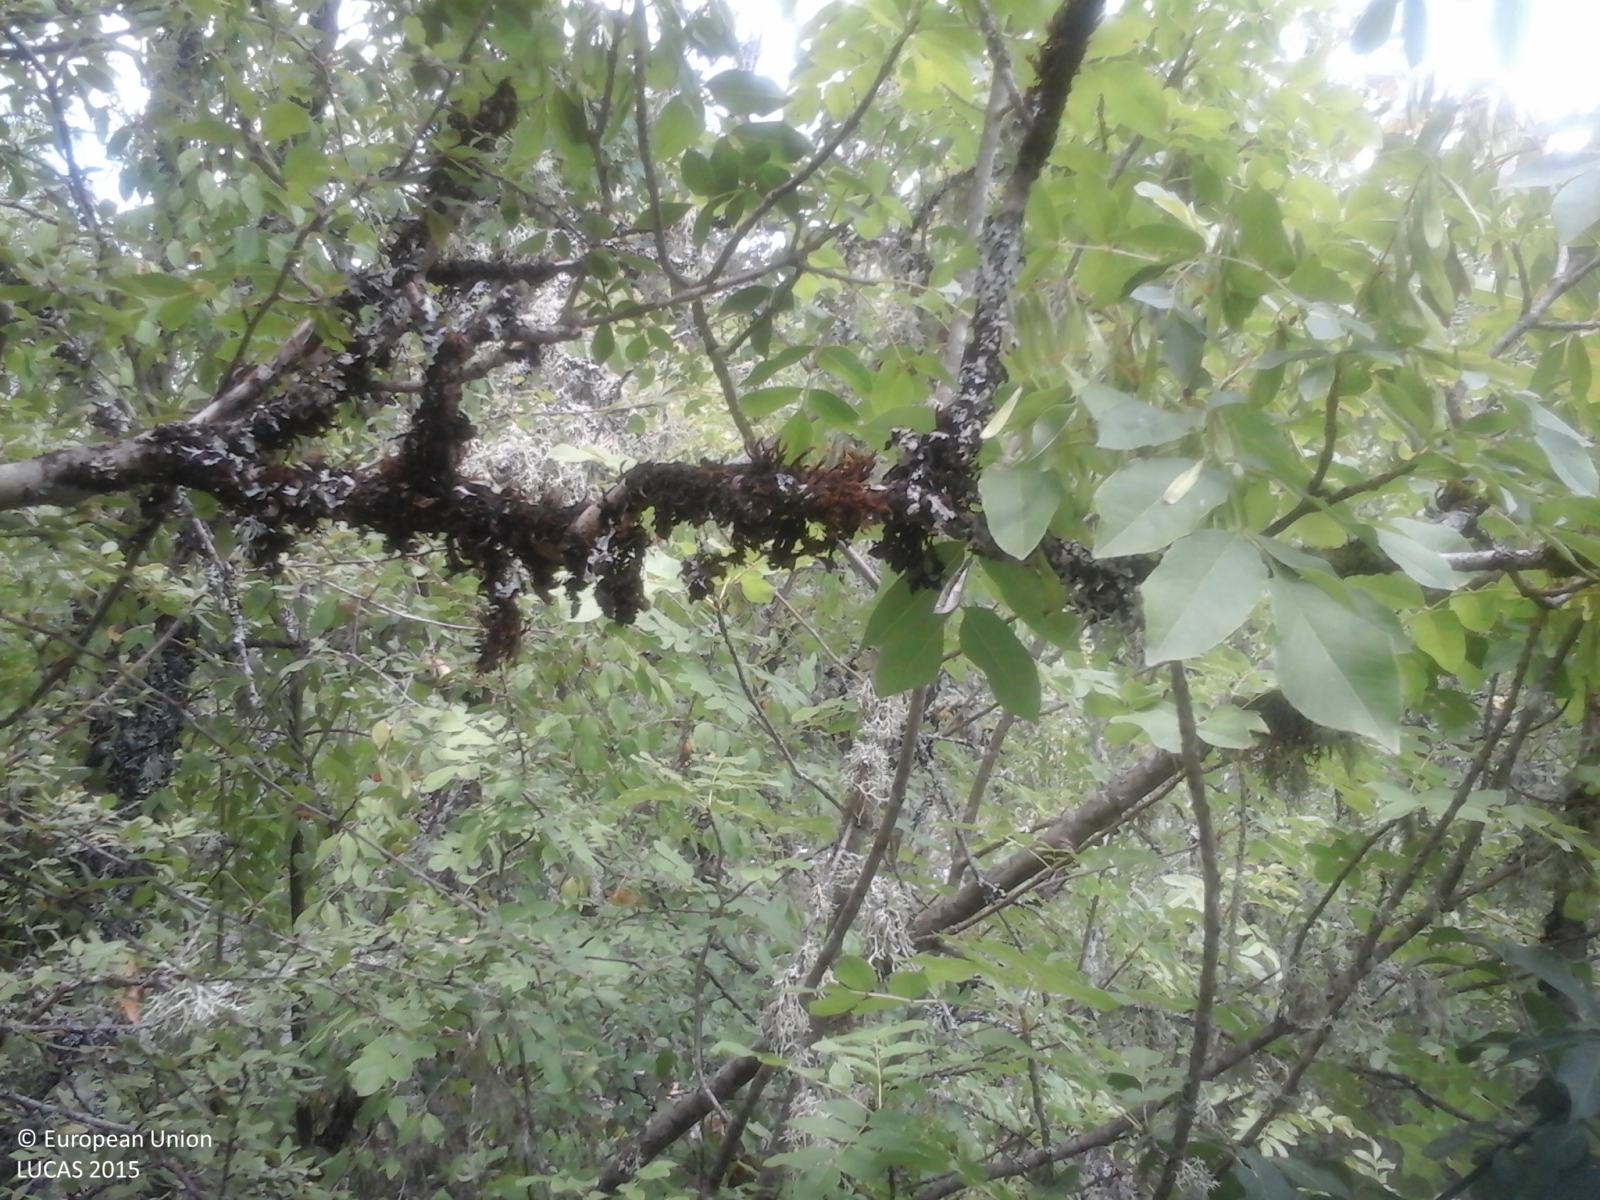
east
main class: Woodland
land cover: Broadleaved woodland
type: thermophilous deciduous forest
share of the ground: > 75 %
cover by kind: broadleaved forest trees 90 %, shrubs 5 %, herbaceous plants 5 %
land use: Semi-natural and natural areas not in use
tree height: < 5 m
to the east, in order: Broadleaved woodland; Tracks; Broadleaved woodland; Dry stone walls; Broadleaved woodland; Dry stone walls; Broadleaved woodland
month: August
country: IT
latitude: 42.2254
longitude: 13.1516
